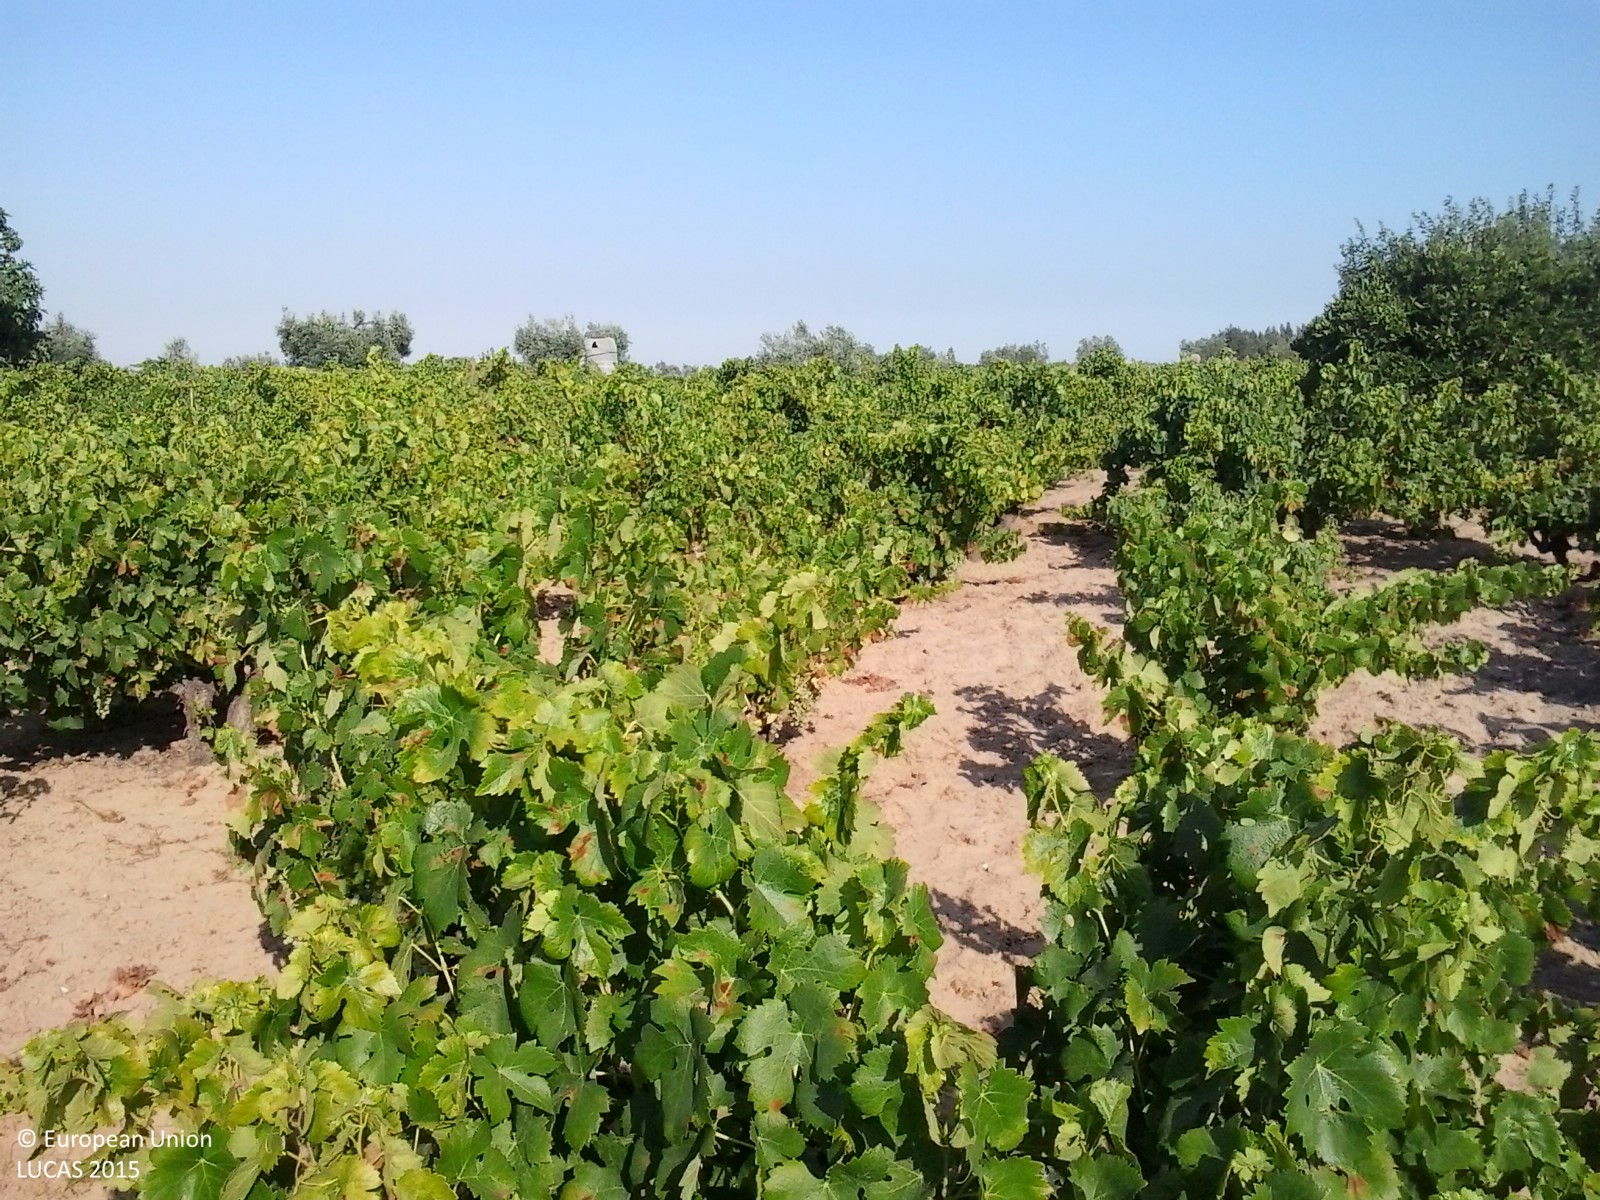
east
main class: Cropland
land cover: Vineyards
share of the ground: 10 - 25 %
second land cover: Other bare soil
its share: > 75 %
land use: Agriculture (excluding fallow land and kitchen gardens)
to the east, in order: Vineyards; Other bare soil; Other fruit trees and berries; Vineyards; Groves; Vineyards; Grass margins; Olive groves; Fences; Grass margins; Olive groves
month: June
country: ES
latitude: 37.3727
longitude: -6.4619
